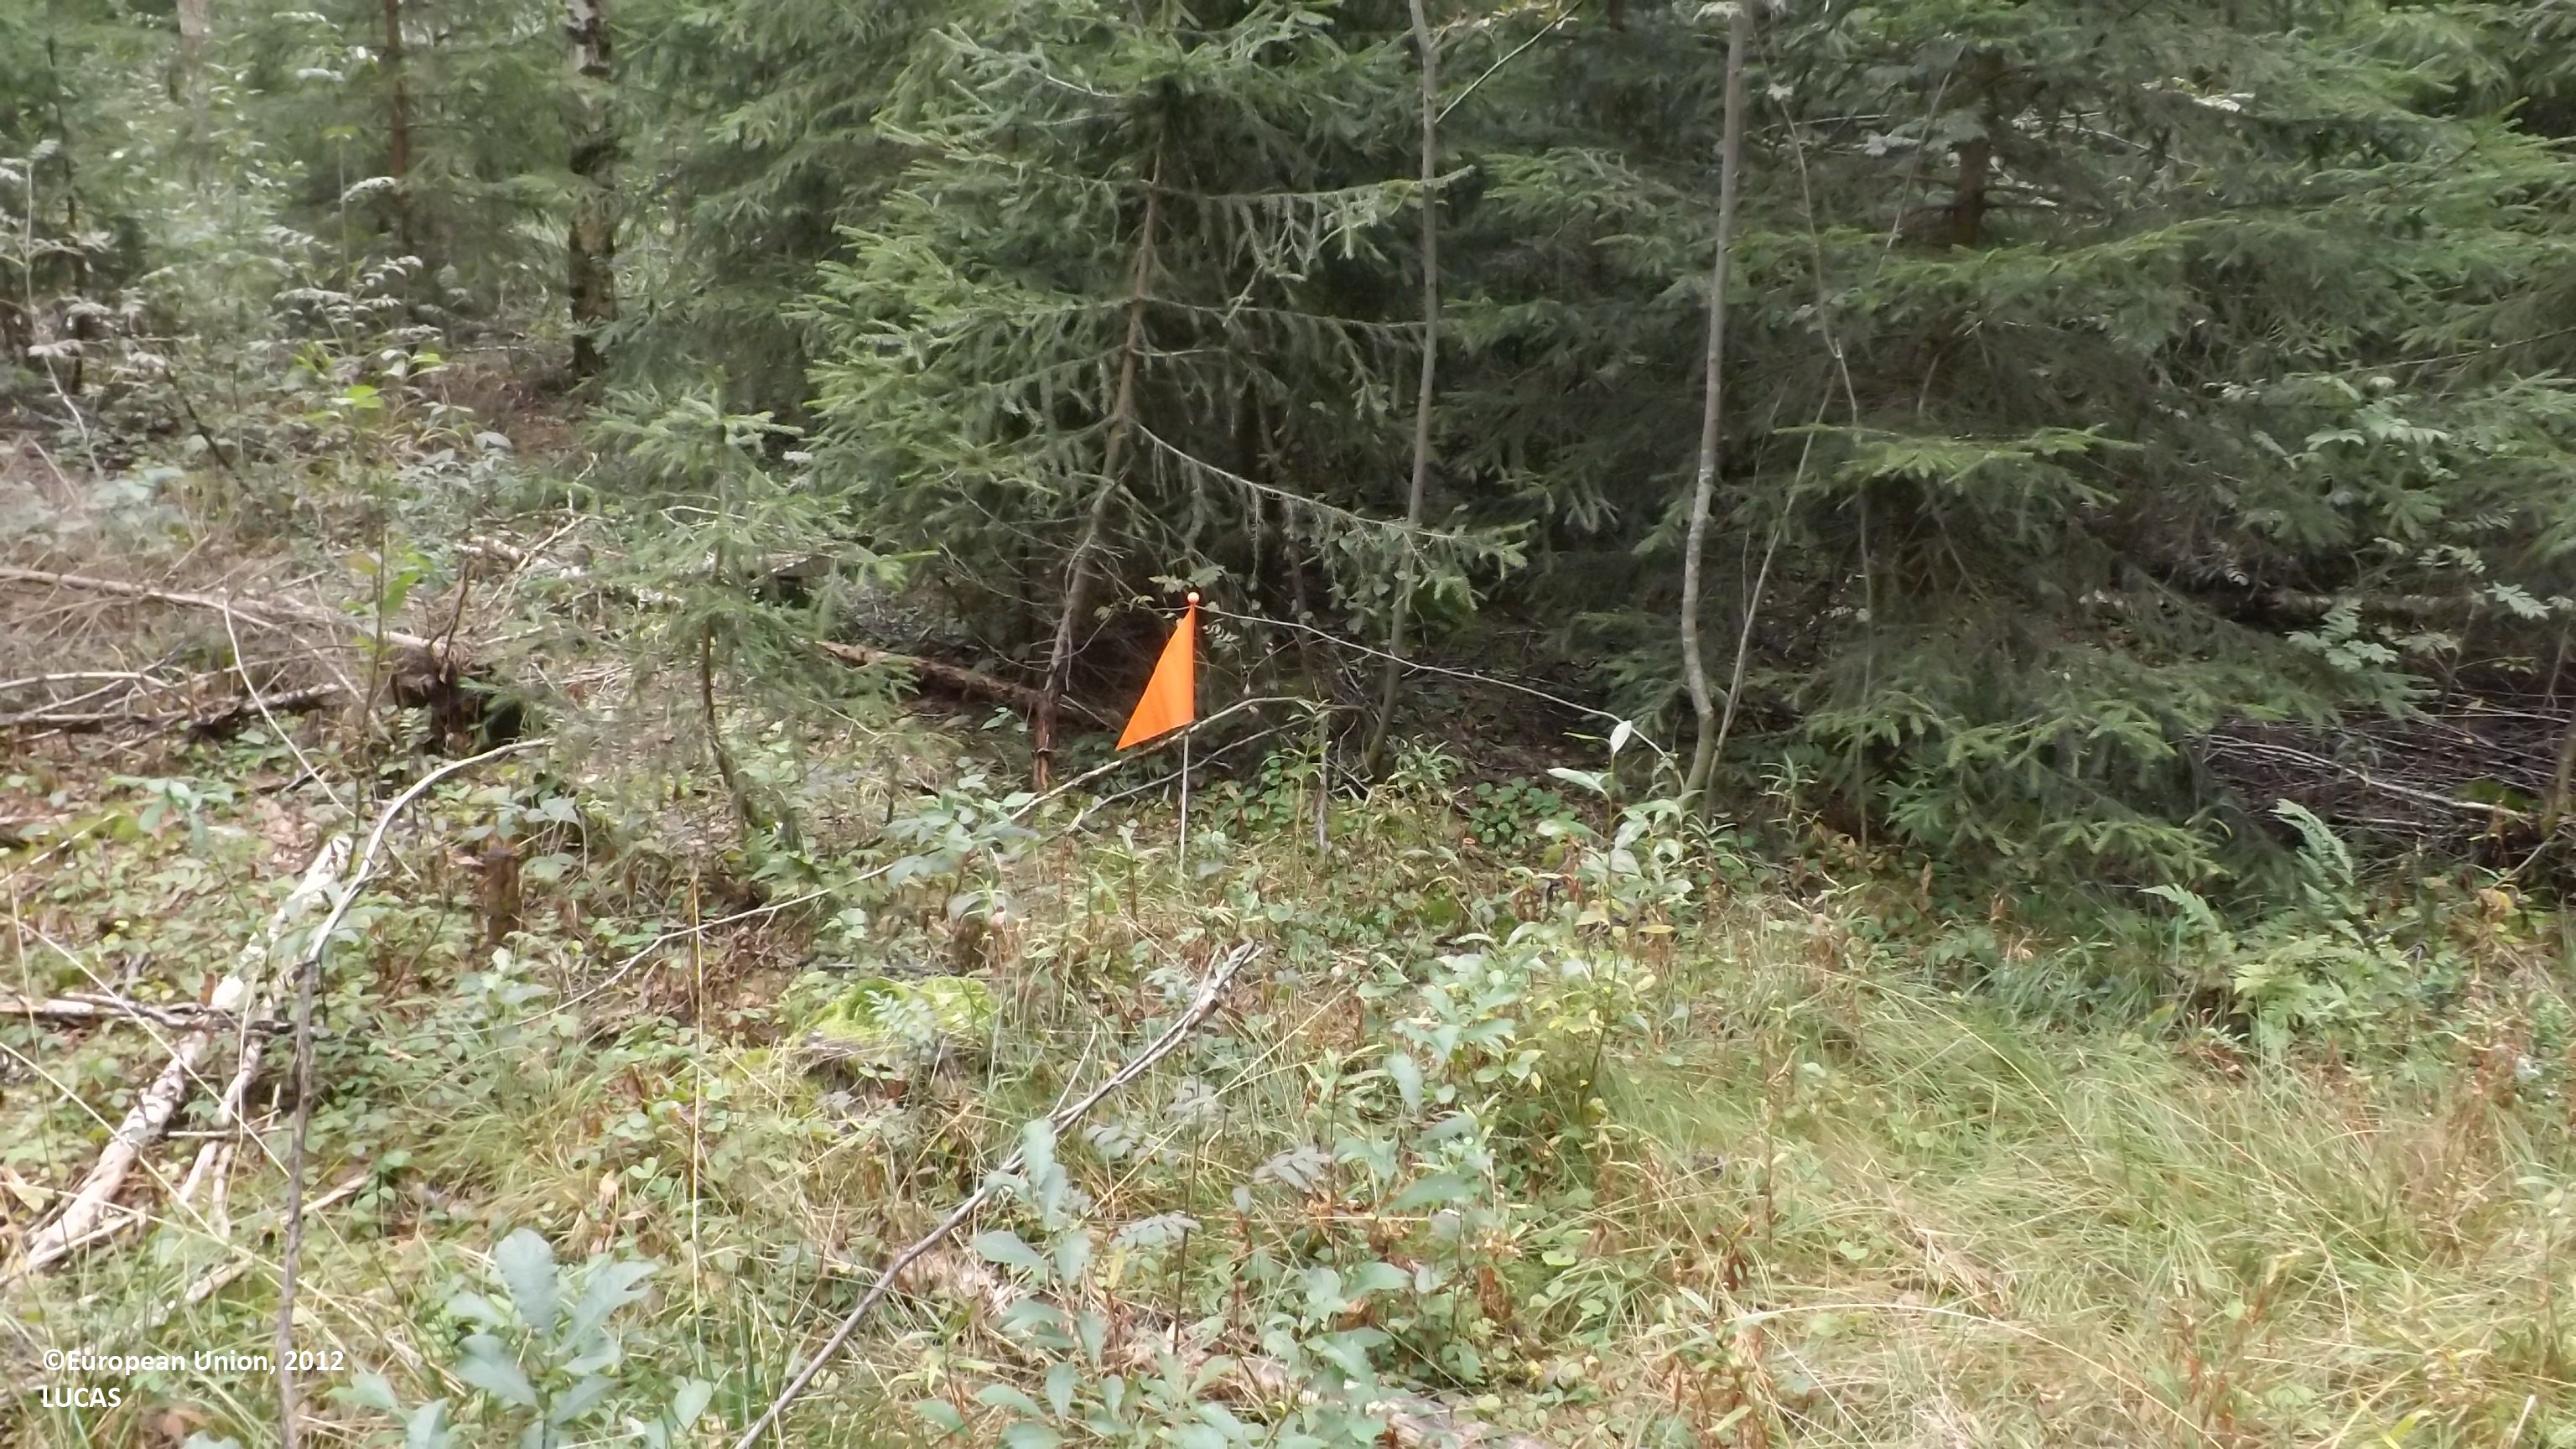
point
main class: Woodland
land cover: Other mixed woodland
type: boreal forest
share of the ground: 50 - 75 %
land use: Forestry
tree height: > 5 m
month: August
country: FI
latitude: 63.7731
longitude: 23.3824
